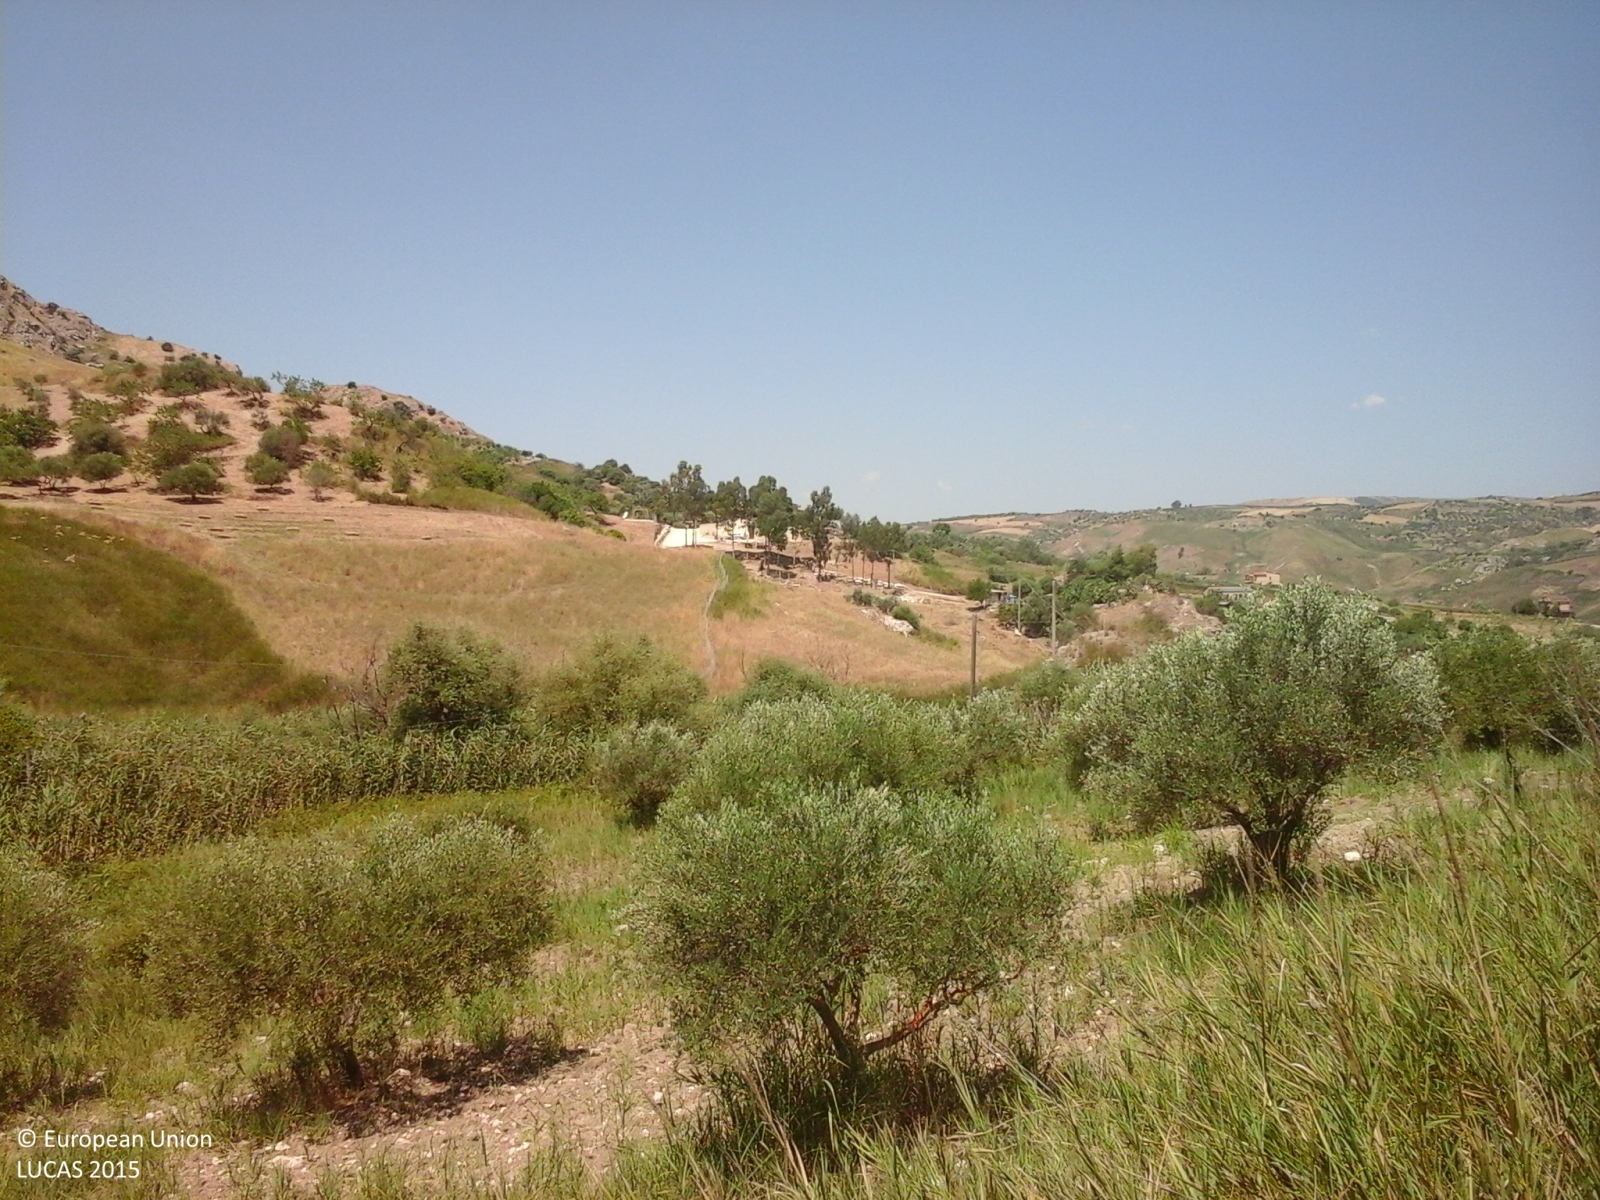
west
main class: Shrubland
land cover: Shrubland without tree cover
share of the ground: > 75 %
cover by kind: herbaceous plants 90 %, shrubs 10 %
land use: Abandoned areas
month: July
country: IT
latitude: 37.4819
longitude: 13.5353
